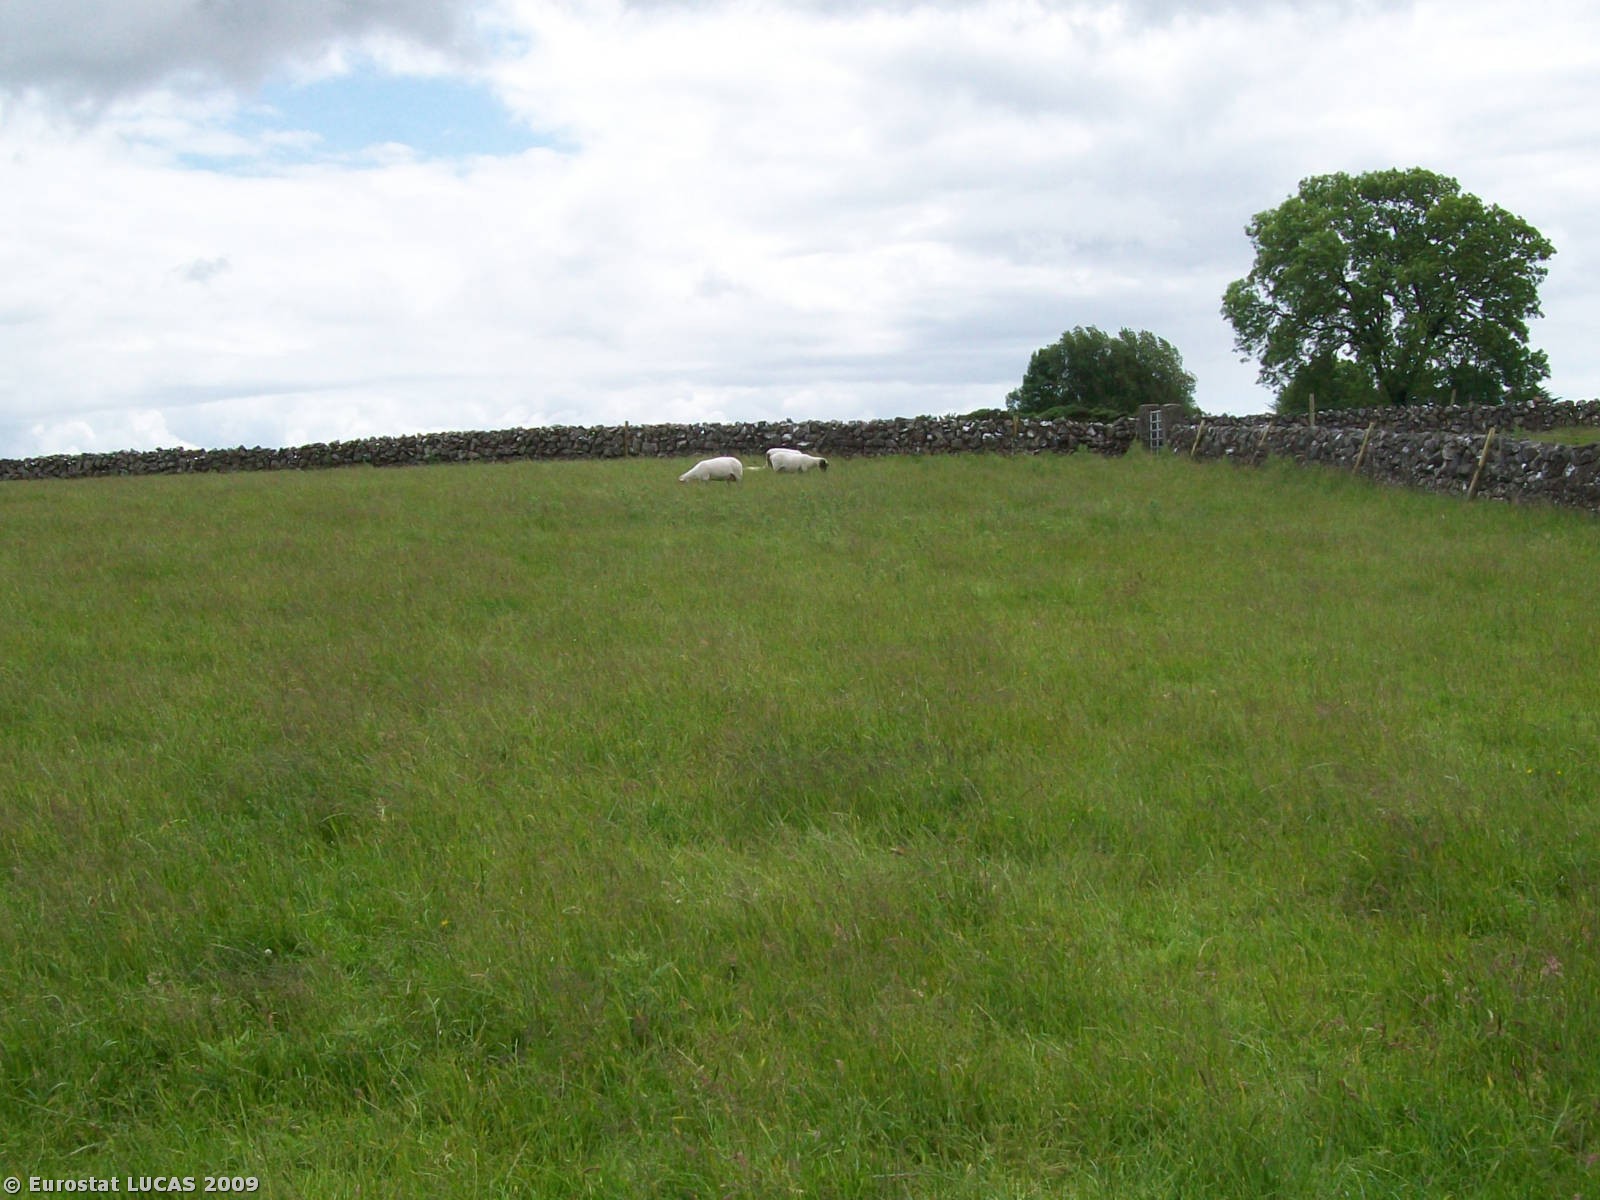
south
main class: Grassland
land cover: Grassland without tree/shrub cover
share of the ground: > 75 %
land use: Agriculture (excluding fallow land and kitchen gardens)
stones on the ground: < 10 %
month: June
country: IE
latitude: 53.3366
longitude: -8.7810
